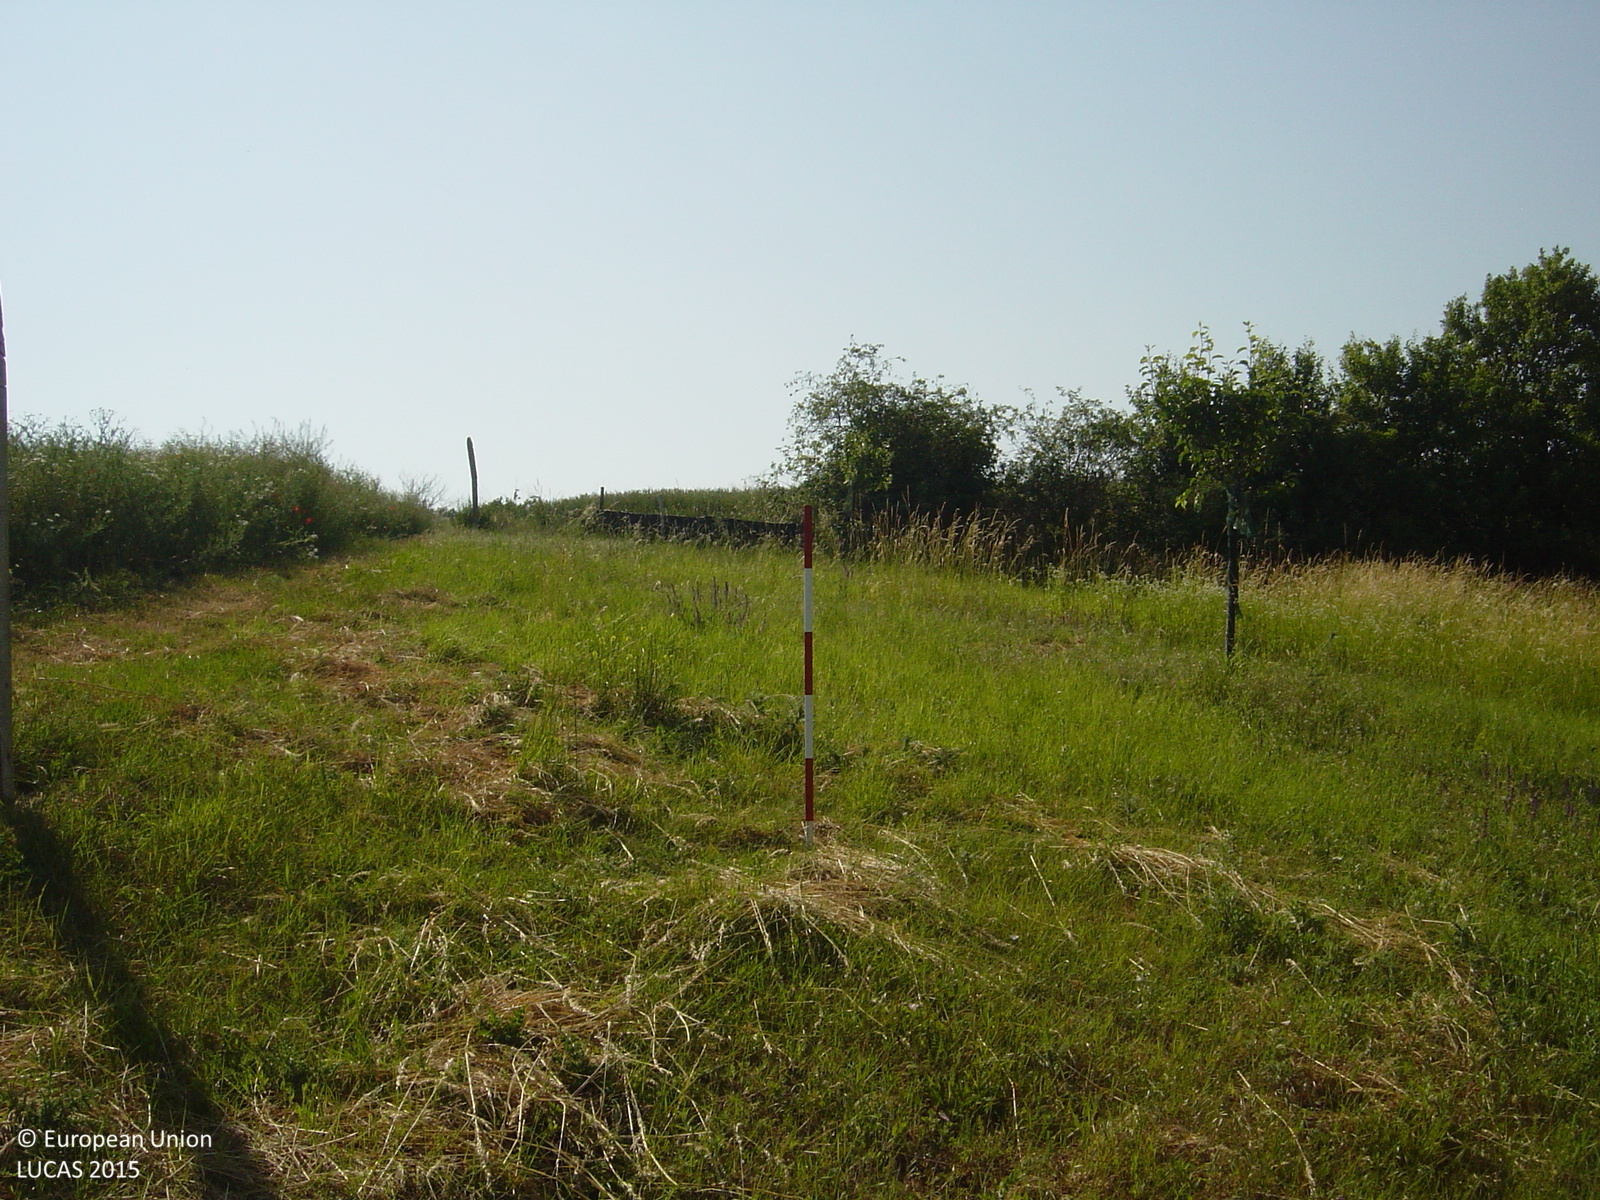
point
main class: Cropland
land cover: Apple fruit
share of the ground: < 10 %
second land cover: Grassland without tree/shrub cover
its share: > 75 %
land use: Kitchen garden
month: June
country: CZ
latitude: 48.9894
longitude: 17.0745
